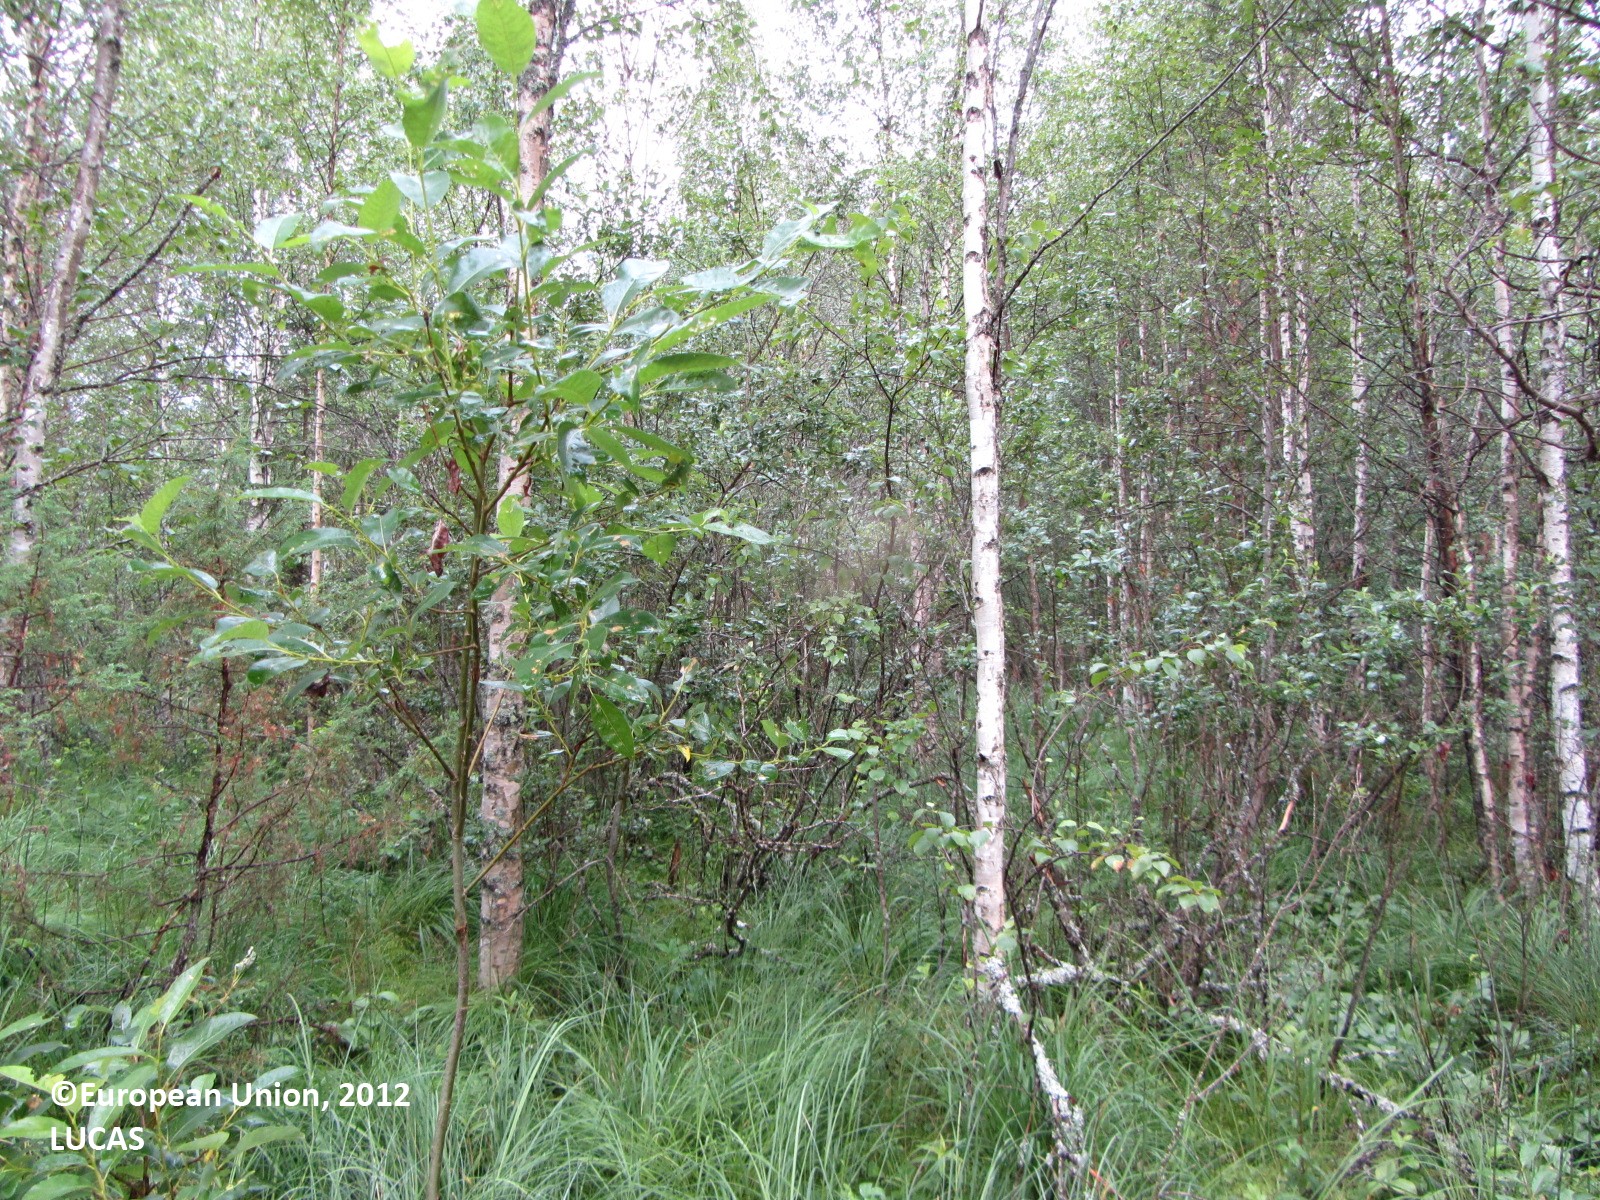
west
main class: Woodland
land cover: Broadleaved woodland
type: mire and swamp forests
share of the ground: 50 - 75 %
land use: Semi-natural and natural areas not in use
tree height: > 5 m
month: July
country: FI
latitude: 63.8792
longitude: 24.8424
